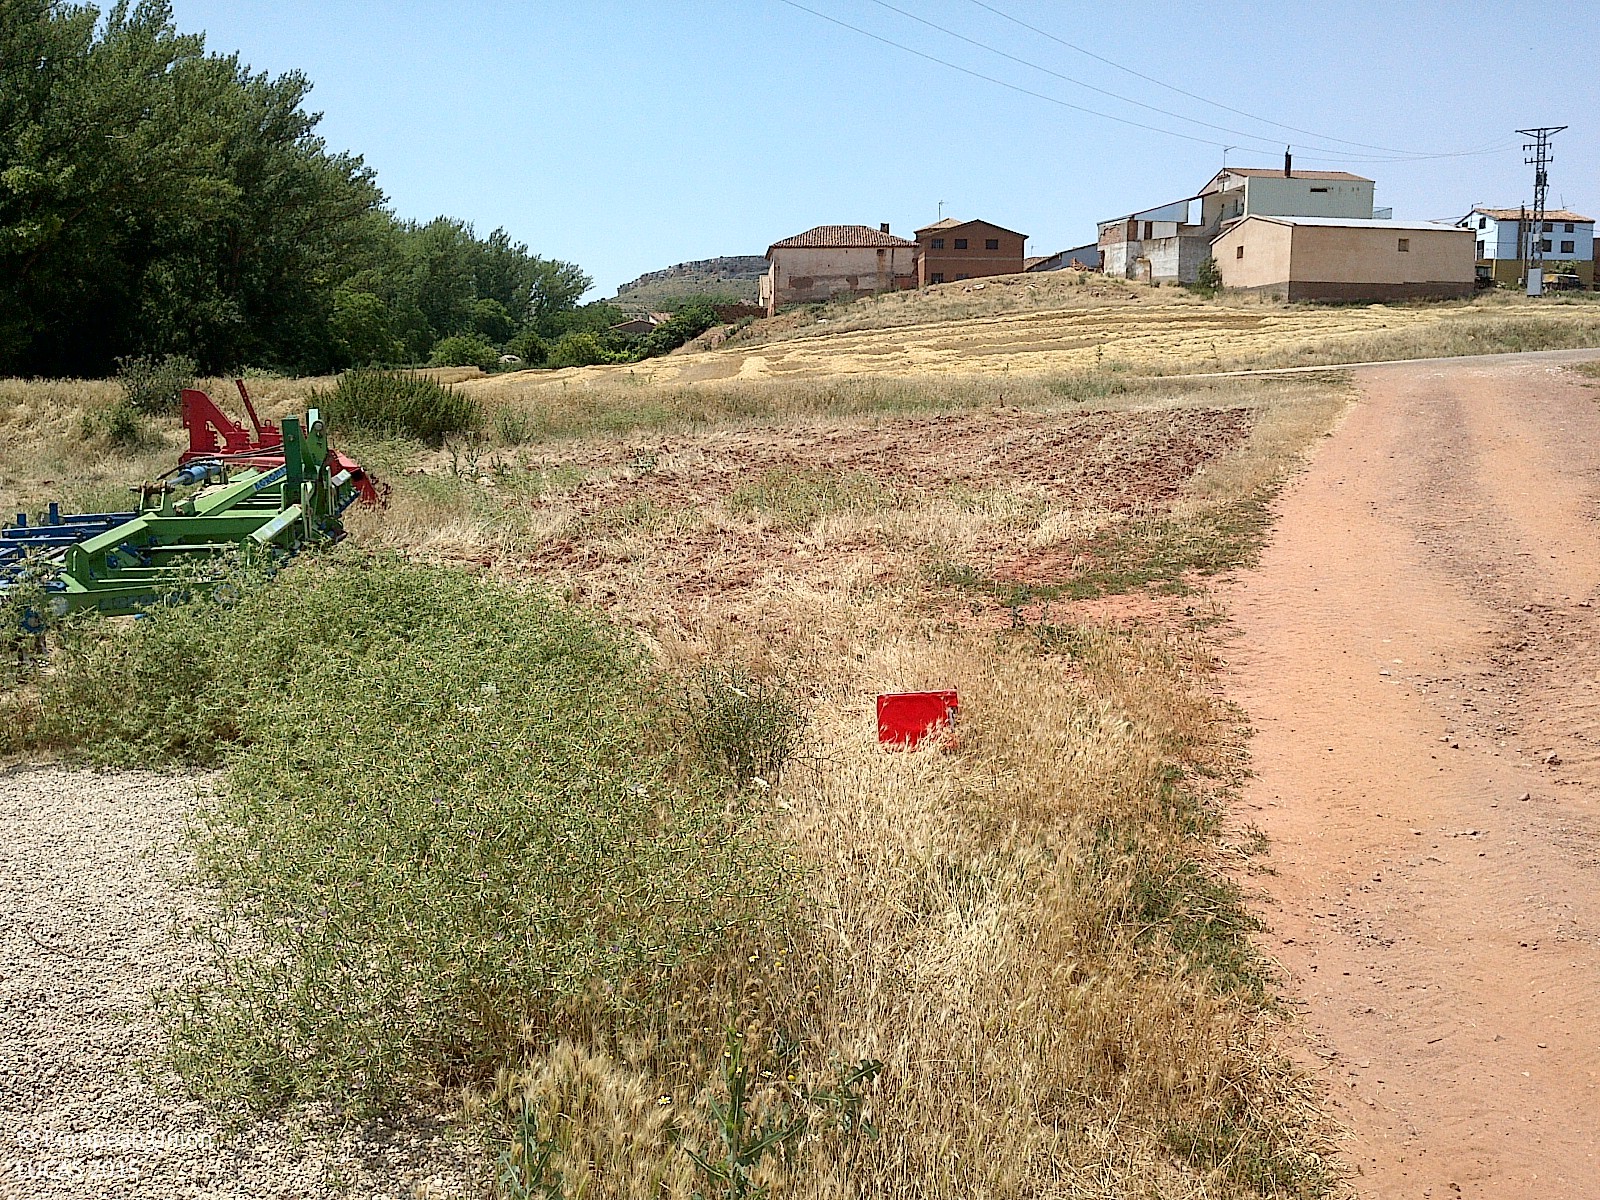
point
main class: Grassland
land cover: Spontaneously vegetated surfaces
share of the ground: 50 - 75 %
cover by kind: herbaceous plants 55 %, unconsolidated bare surface 45 %
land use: Fallow land
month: July
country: ES
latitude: 41.5687
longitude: -2.0354
